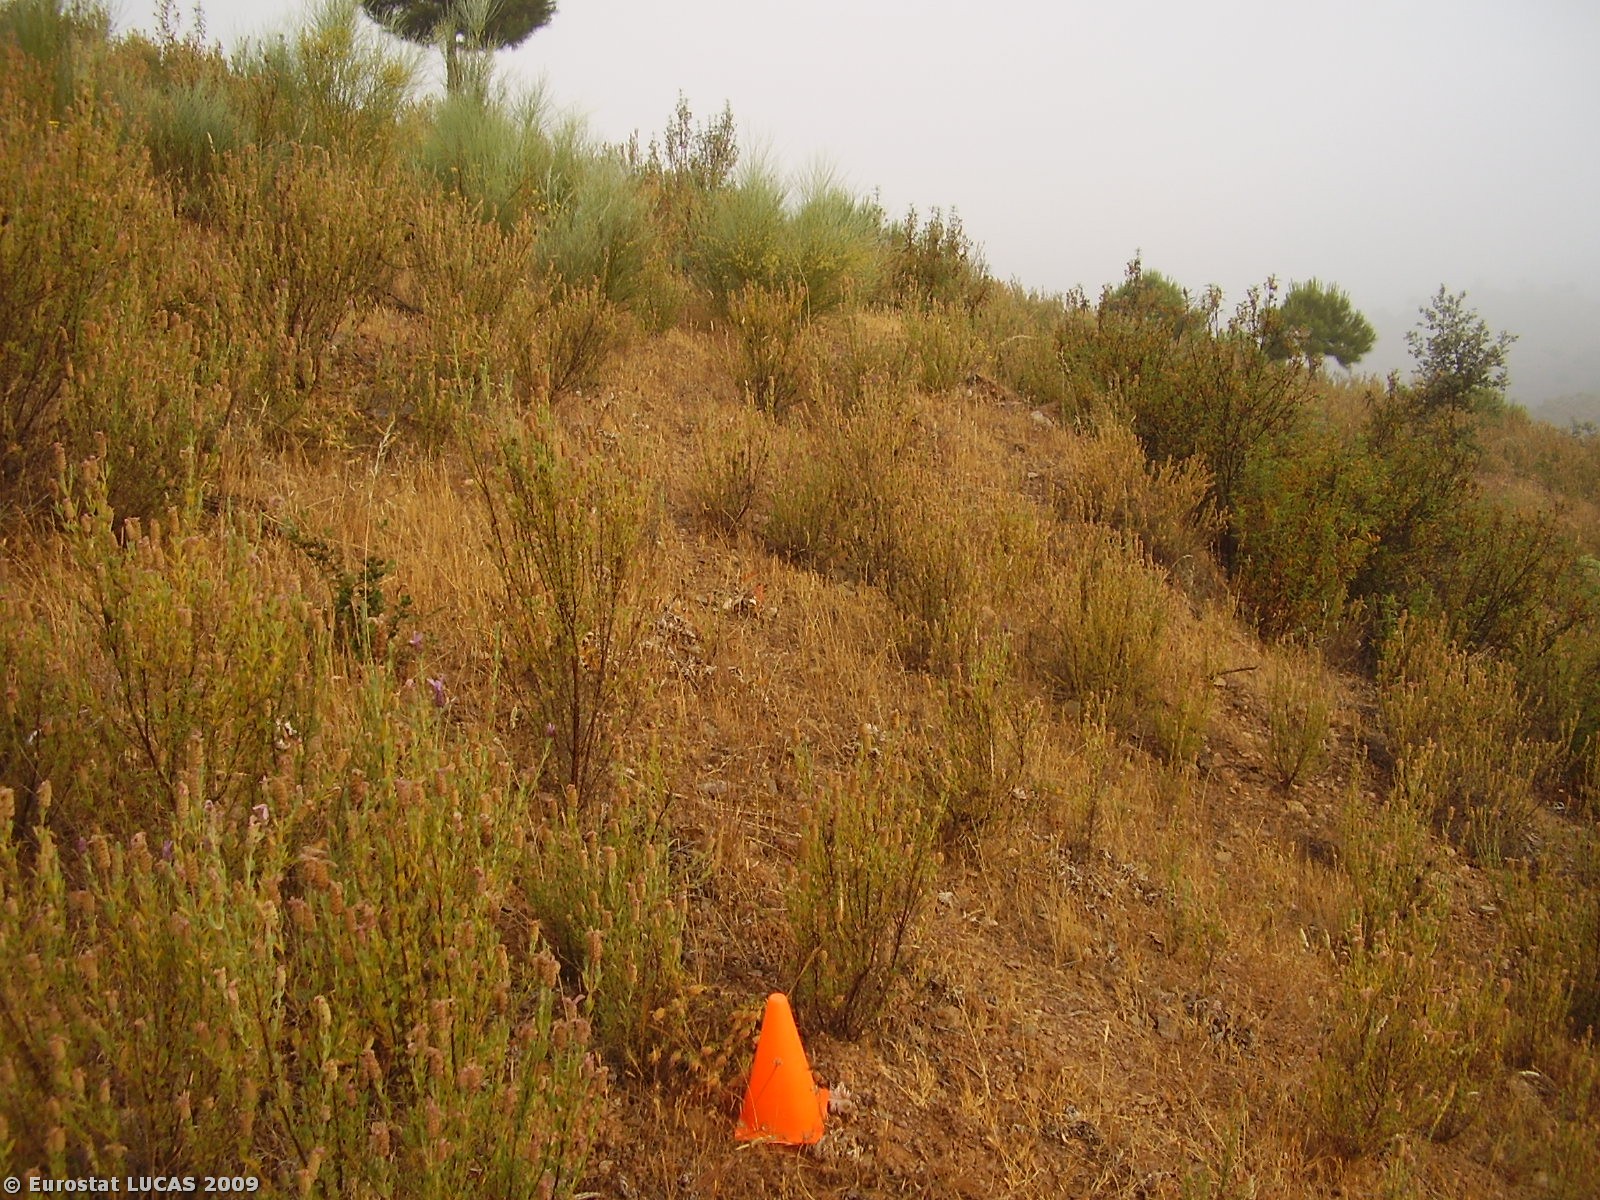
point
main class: Shrubland
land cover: Shrubland with sparse tree cover
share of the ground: 25 - 50 %
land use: Unused
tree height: > 5 m
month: May
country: PT
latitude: 37.6388
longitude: -7.6371
